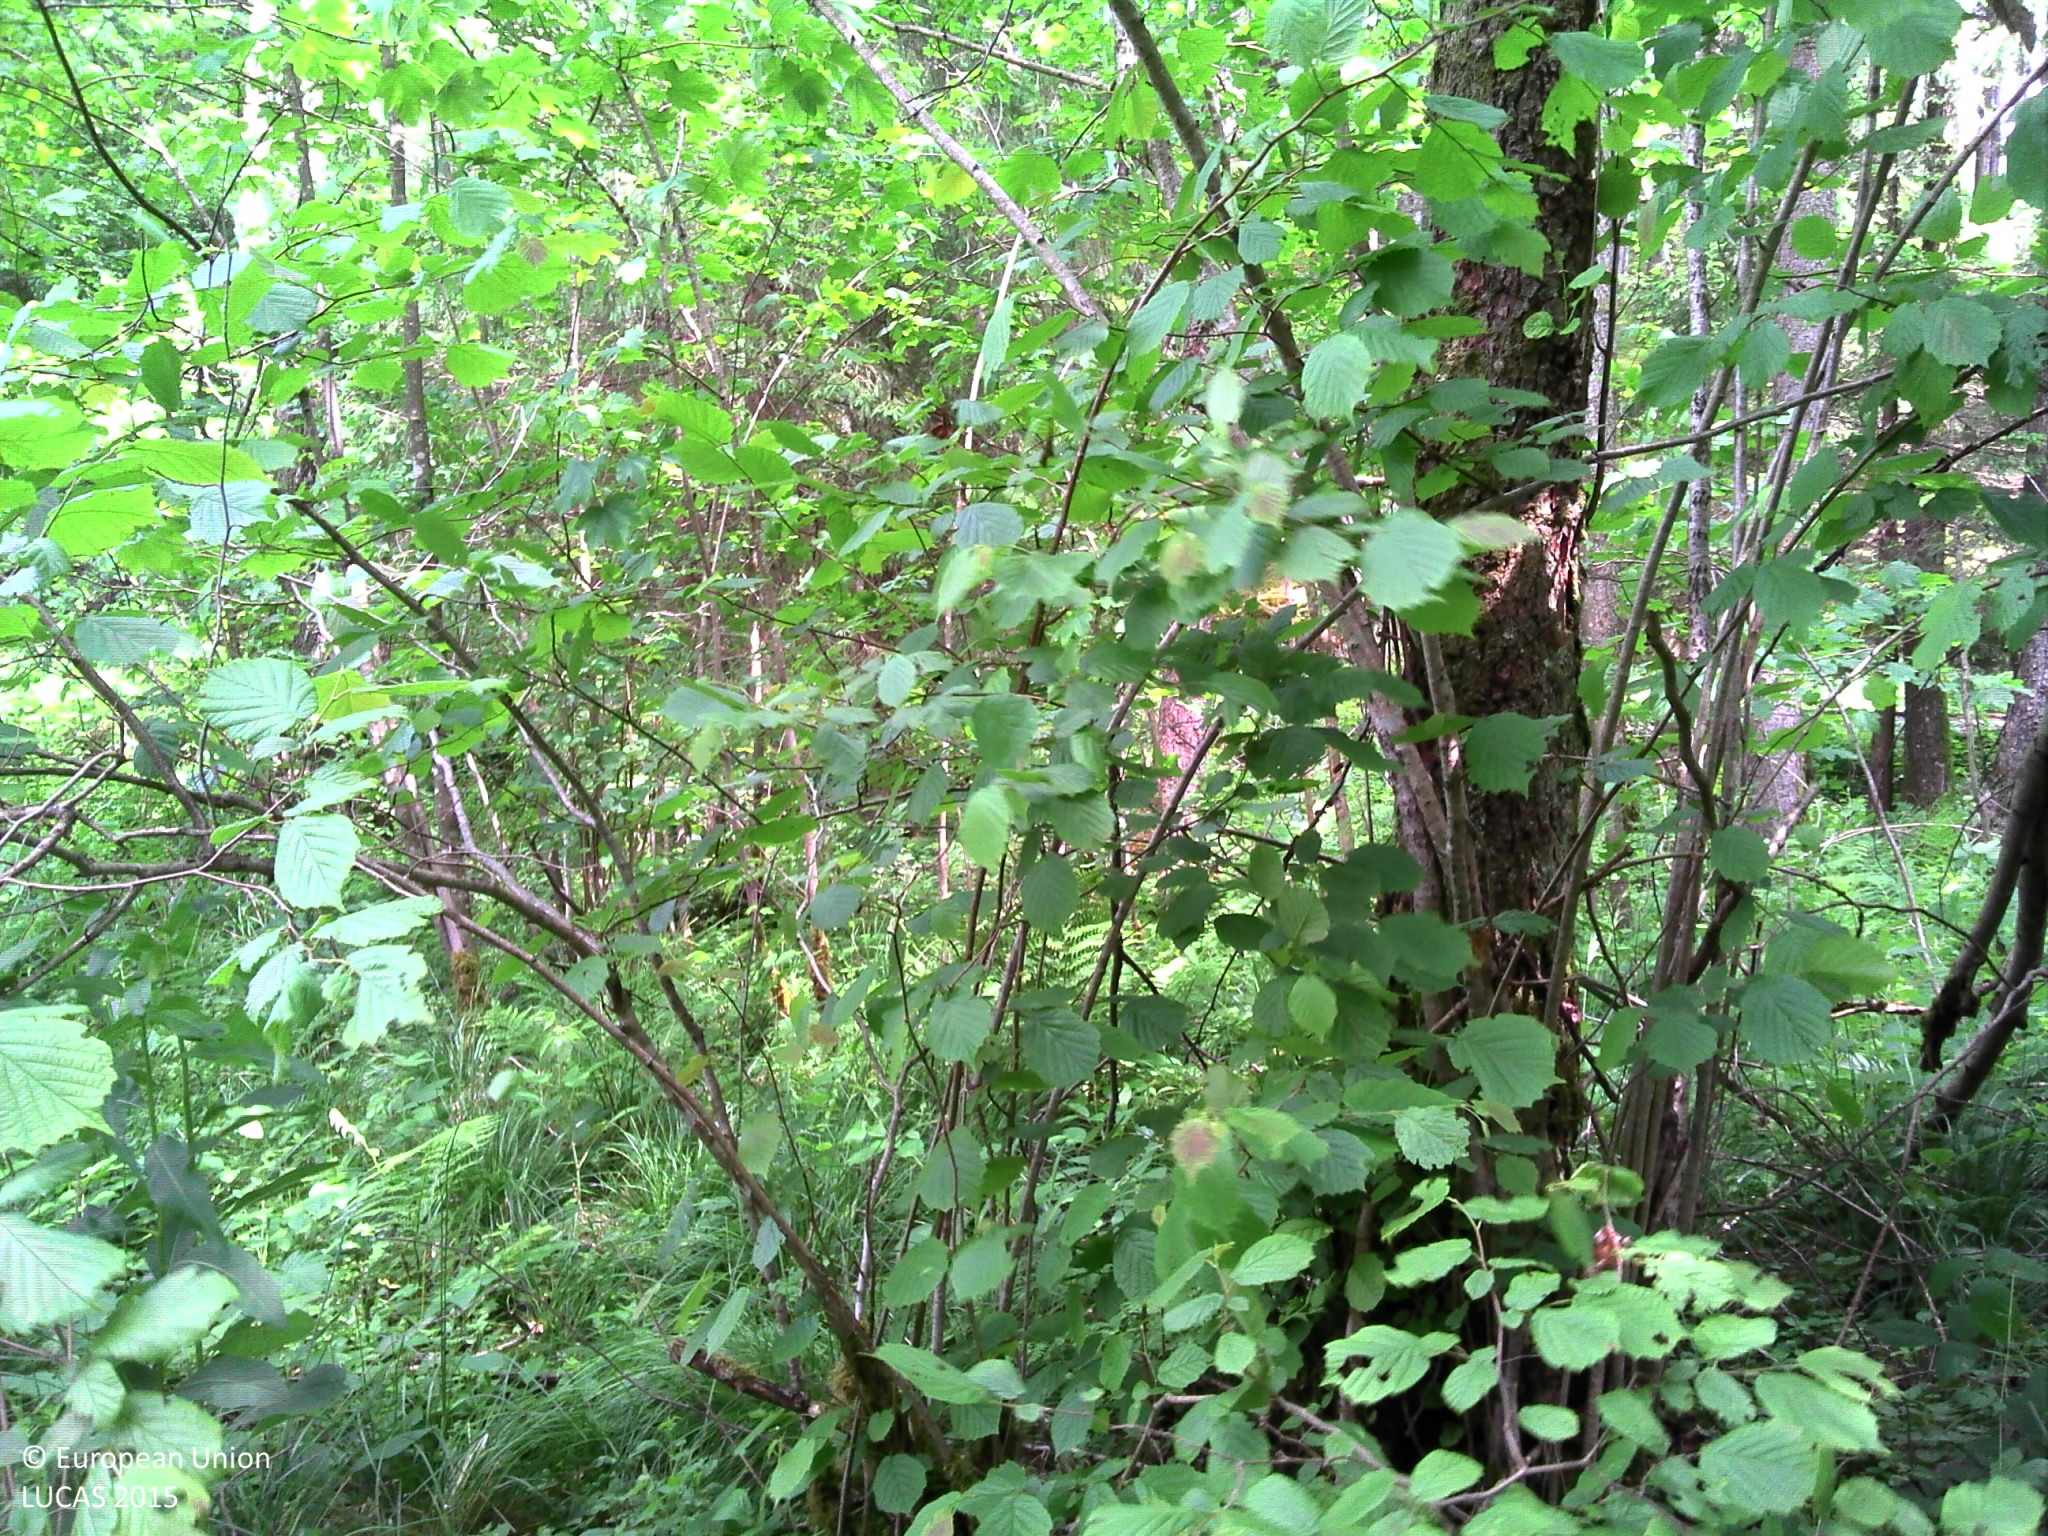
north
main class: Woodland
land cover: Broadleaved woodland
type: floodplain forest
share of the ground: > 75 %
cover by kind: broadleaved forest trees 85 %, coniferous forest trees 10 %, herbaceous plants 5 %
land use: Forestry
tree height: > 5 m
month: June
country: BE
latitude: 50.2438
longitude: 5.6094
